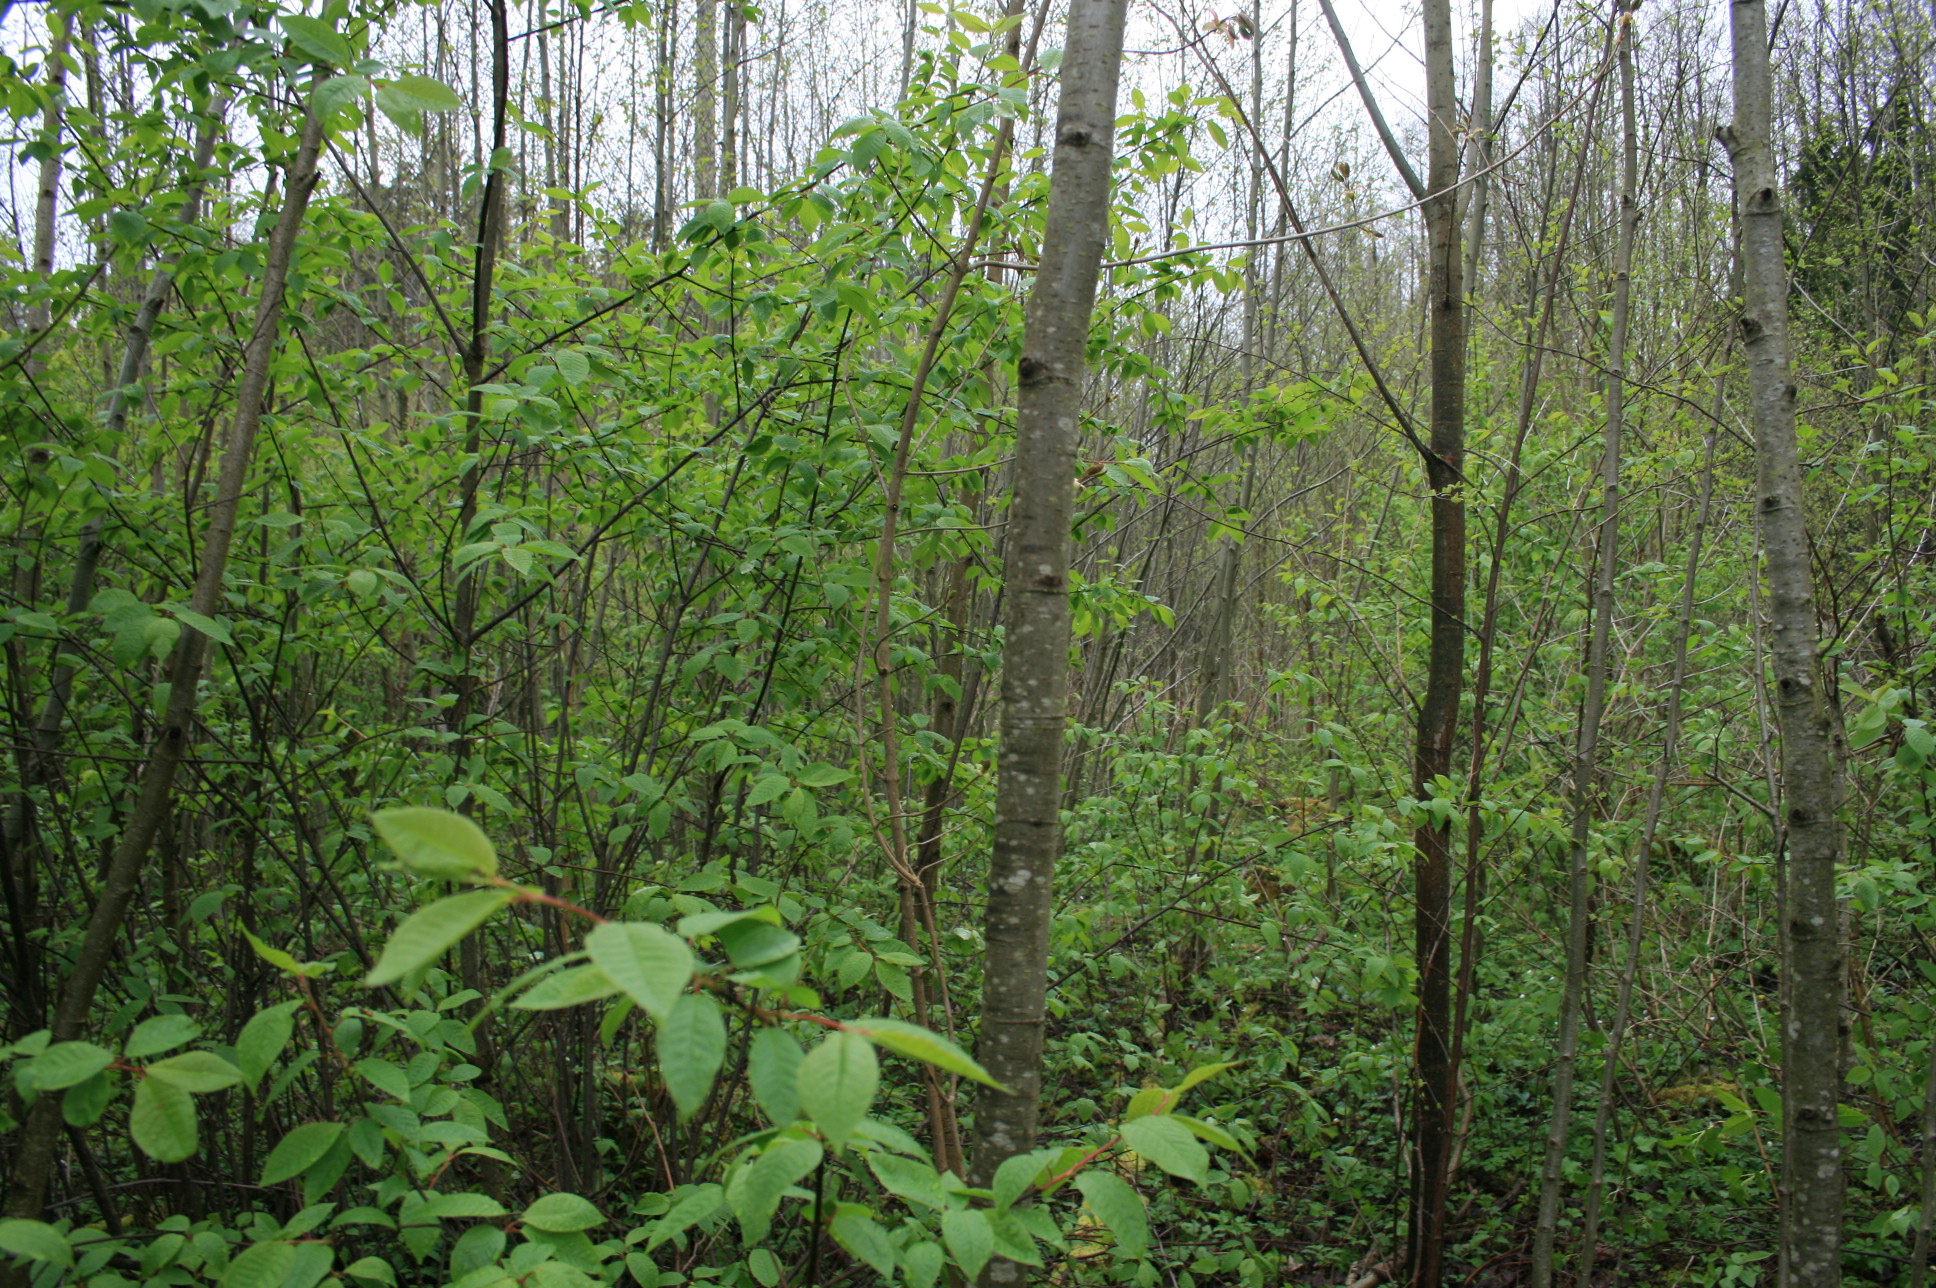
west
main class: Woodland
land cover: Broadleaved woodland
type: non-riverine alder, birch or aspen forest
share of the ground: 50 - 75 %
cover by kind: broadleaved forest trees 70 %, shrubs 20 %, herbaceous plants 10 %
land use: Forestry
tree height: > 5 m
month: May
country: LT
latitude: 56.3758
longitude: 22.1150
